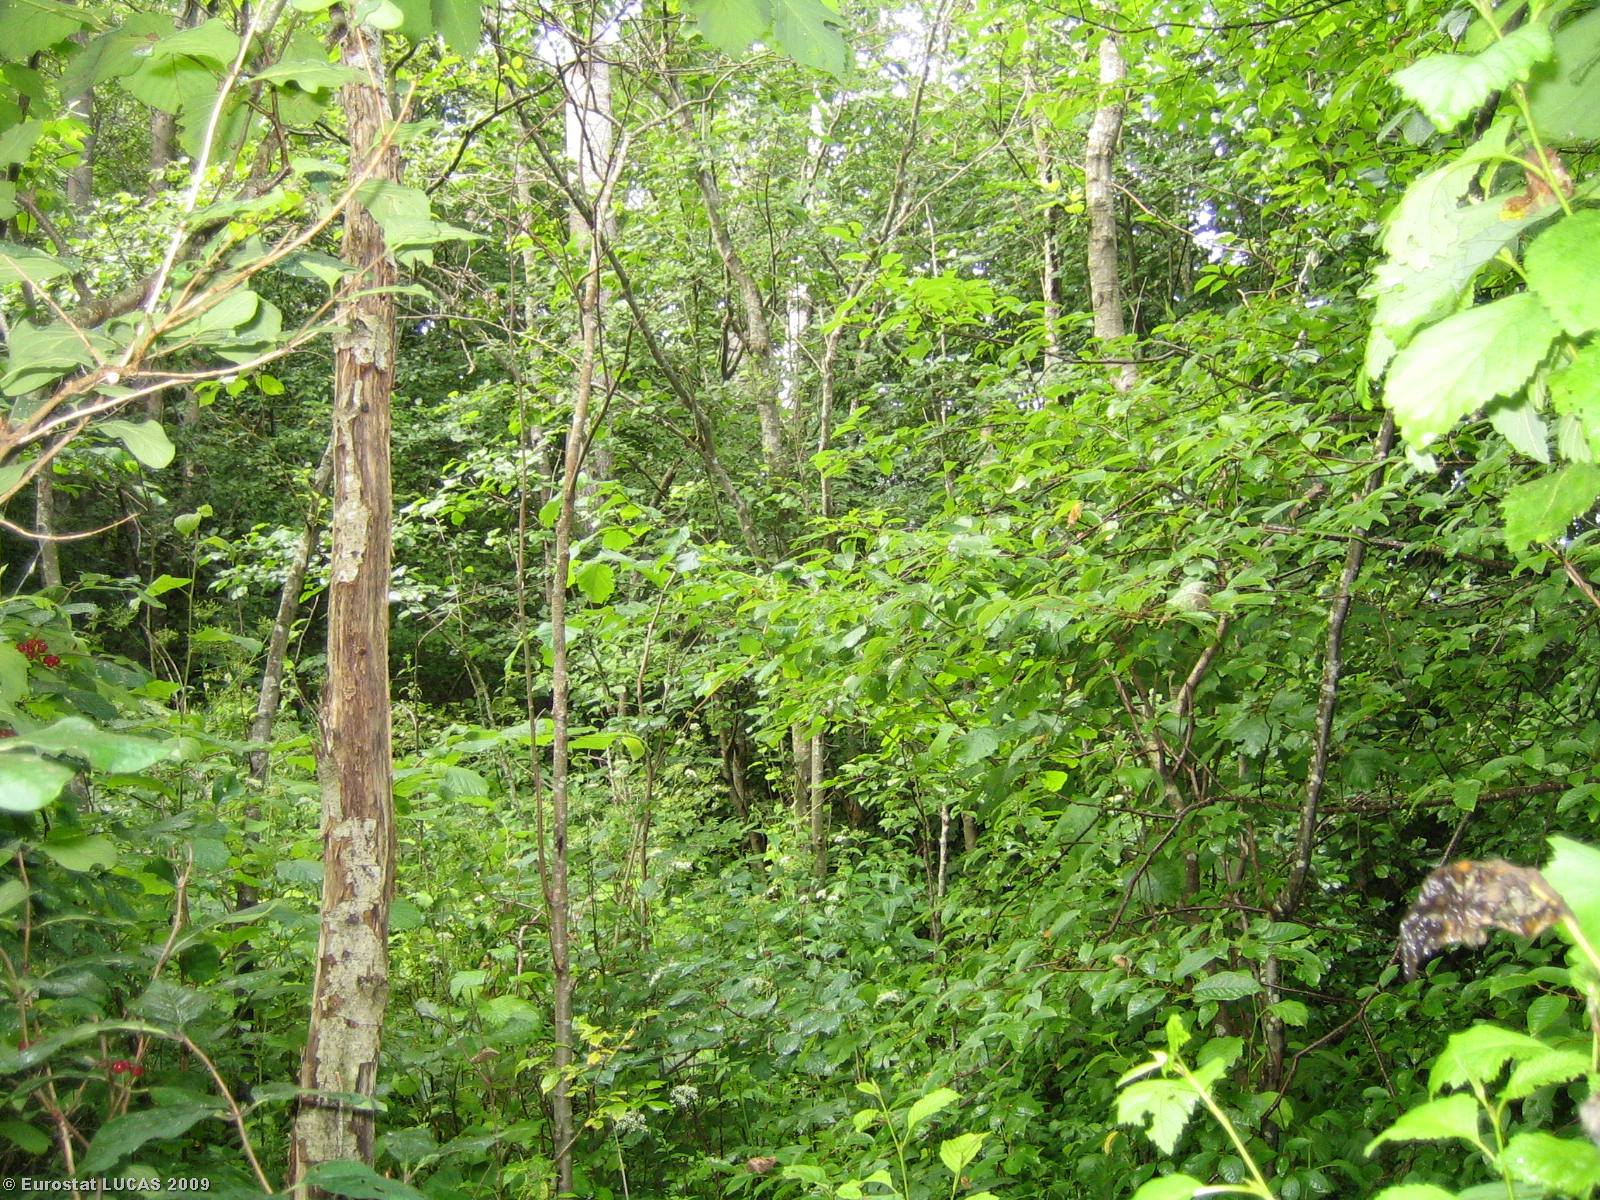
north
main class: Woodland
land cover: Mixed woodland
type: hemiboreal forest and nemoral coniferous forest and mixed broadleaved-coniferous forest
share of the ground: > 75 %
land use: Forestry
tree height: > 5 m
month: July
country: LT
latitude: 55.4619
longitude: 25.9033
